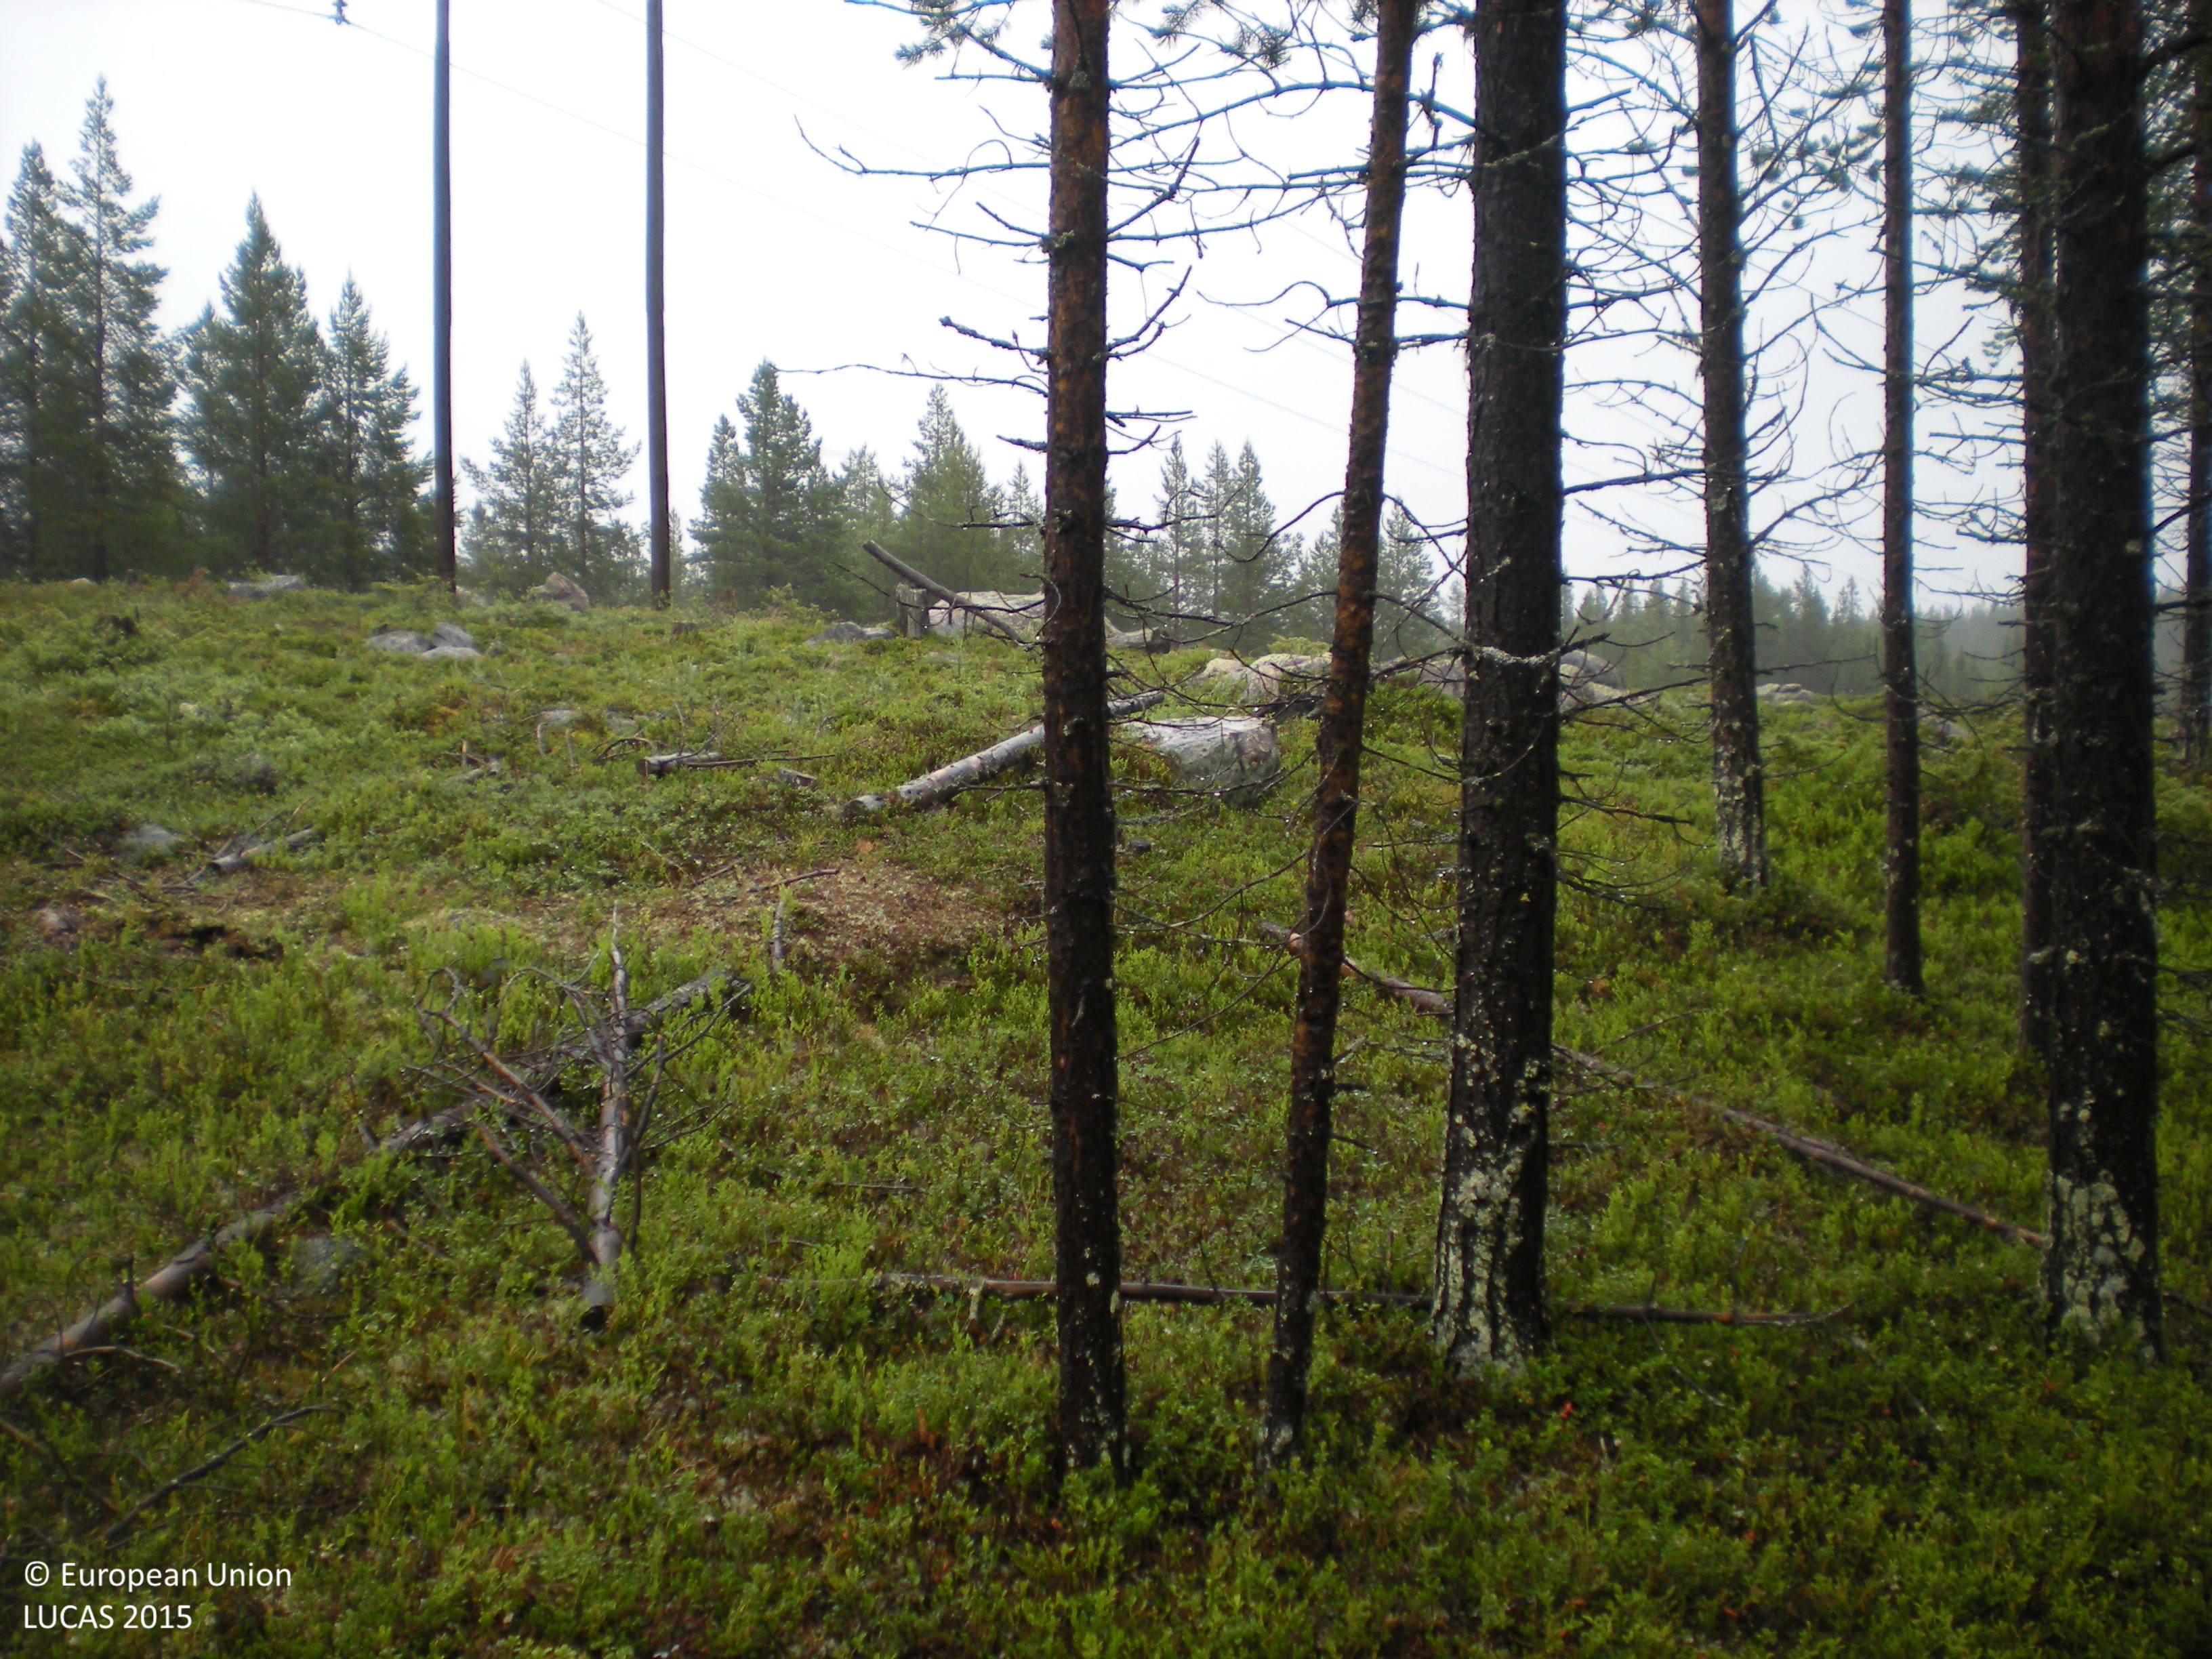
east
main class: Woodland
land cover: Pine dominated coniferous woodland
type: boreal forest
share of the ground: 50 - 75 %
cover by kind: coniferous forest trees 60 %, shrubs 35 %, lichens and mosses 5 %
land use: Forestry
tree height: > 5 m
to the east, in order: Pine dominated coniferous woodland; Shrubland without tree cover; Electric lines; Shrubland without tree cover; Pine dominated coniferous woodland; Rocks and stones; Pine dominated mixed woodland; Rocks and stones; Pine dominated mixed woodland
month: July
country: SE
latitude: 65.9655
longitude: 18.2512
